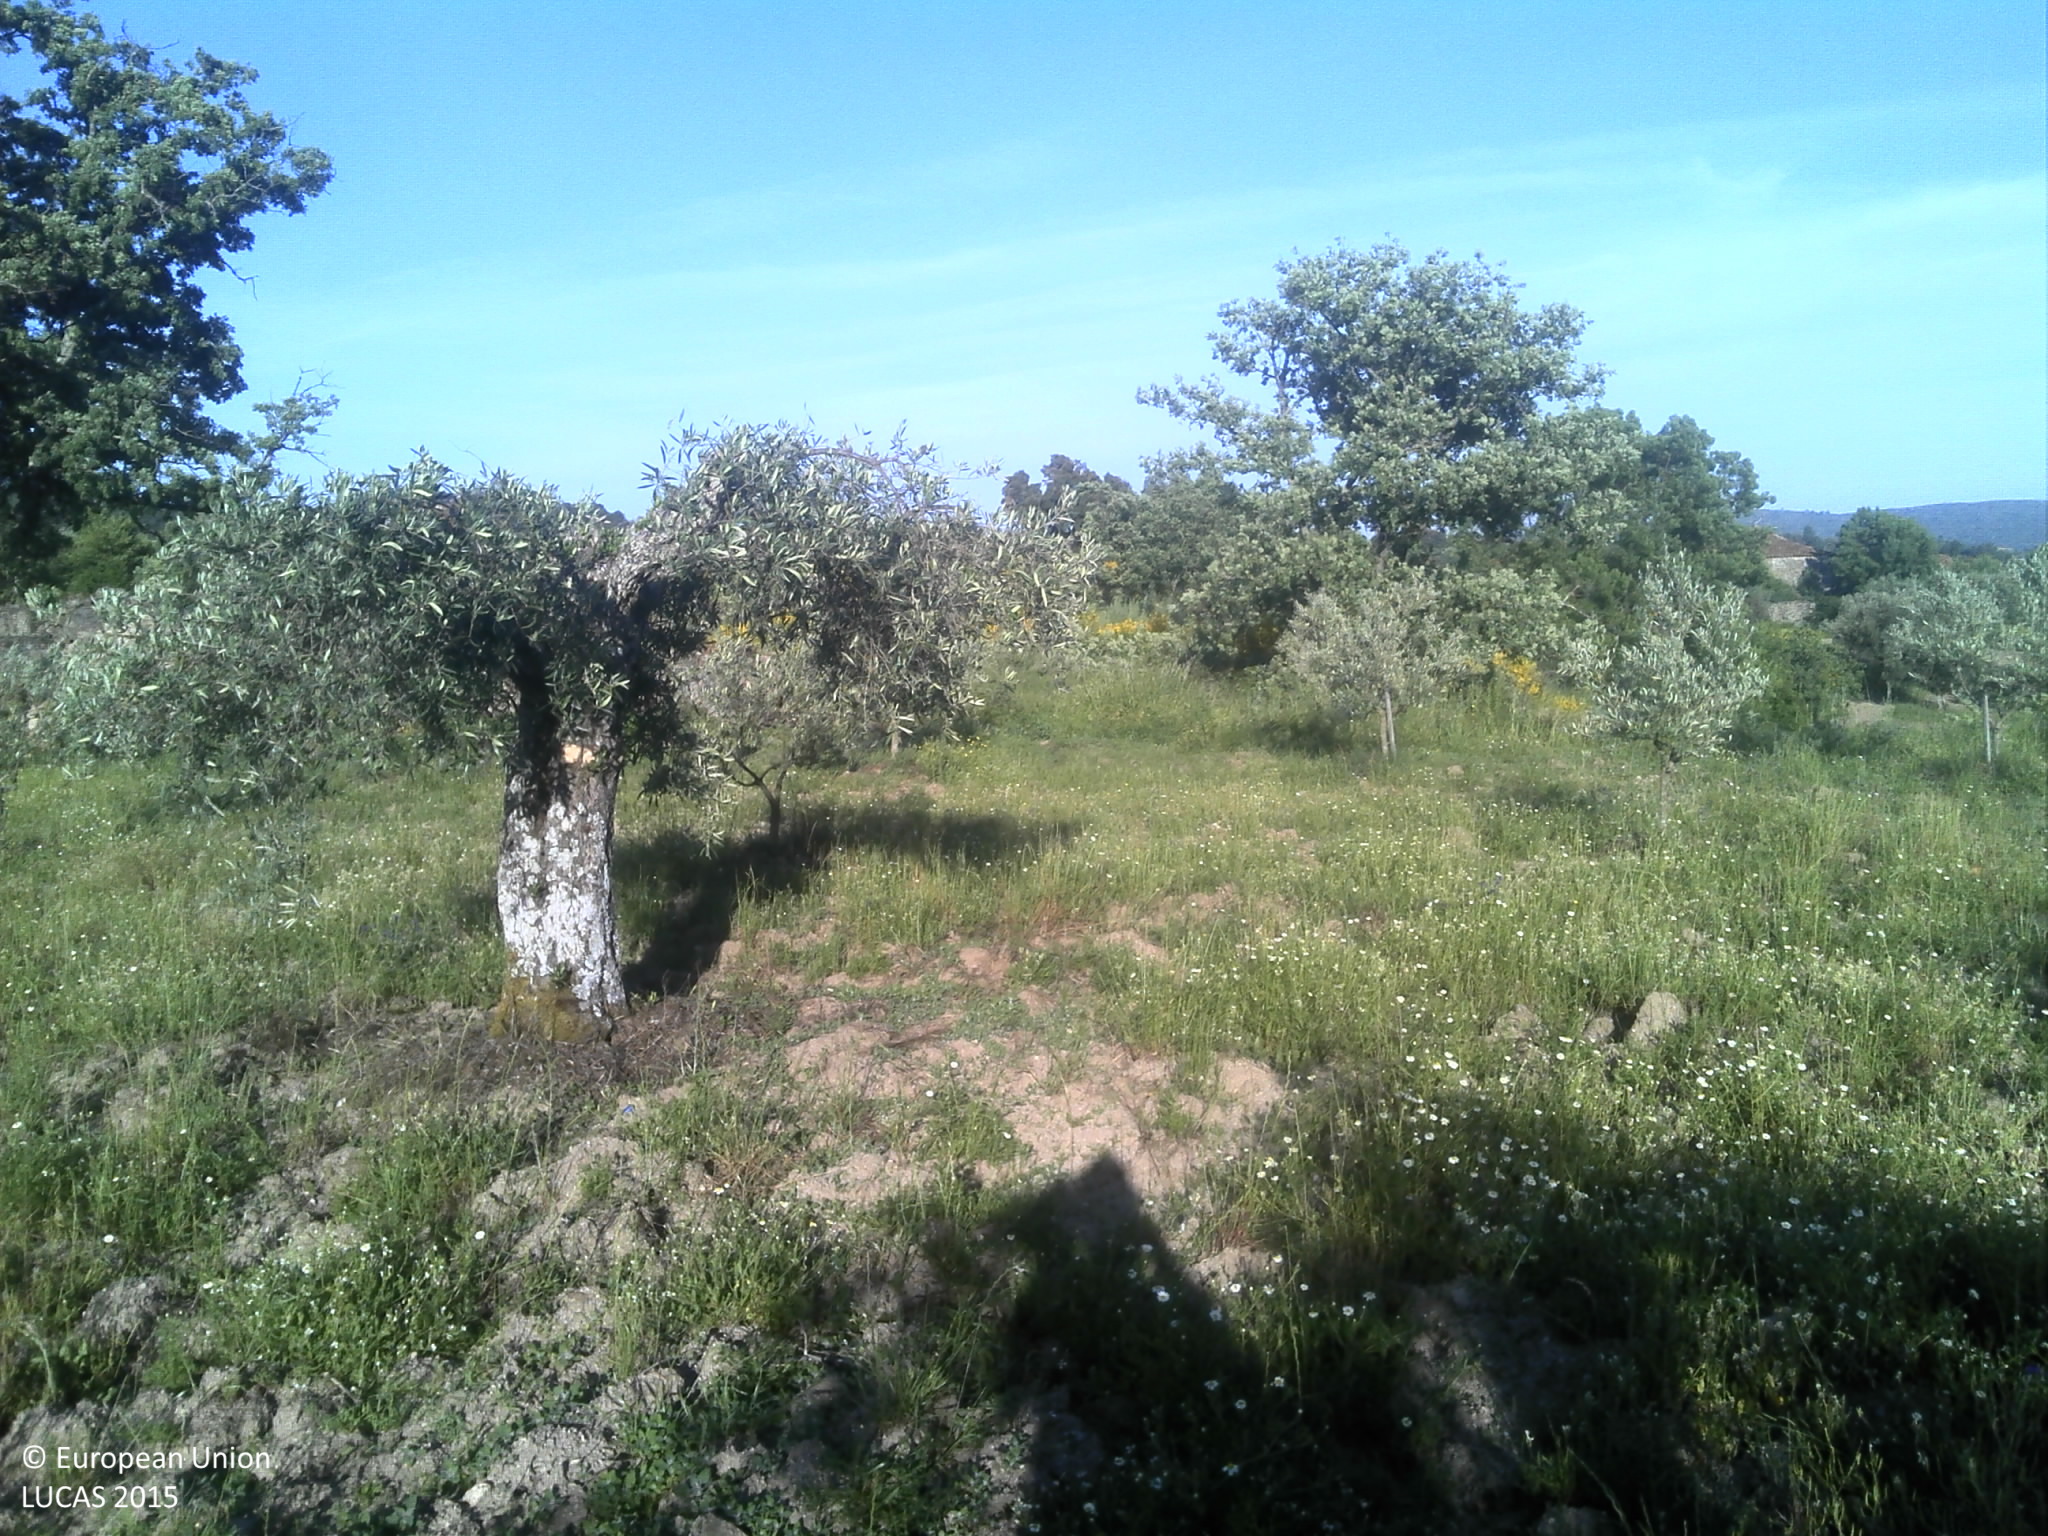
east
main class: Cropland
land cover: Olive groves
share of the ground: 25 - 50 %
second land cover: Grassland without tree/shrub cover
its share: 25 - 50 %
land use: Agriculture (excluding fallow land and kitchen gardens)
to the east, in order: Olive groves; Grassland without tree/shrub cover; Olive groves; Dry stone walls; Shrubland without tree cover; Tracks; Dry stone walls; Rocks and stones; Shrubland without tree cover; Tracks; Shrubland with sparse tree cover; Maize; Dry stone walls; Rivers and streams; Dry stone walls; Grassland without tree/shrub cover; Olive groves; Shrubland without tree cover; Dry stone walls; Olive groves
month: May
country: PT
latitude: 40.7174
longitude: -7.3592
